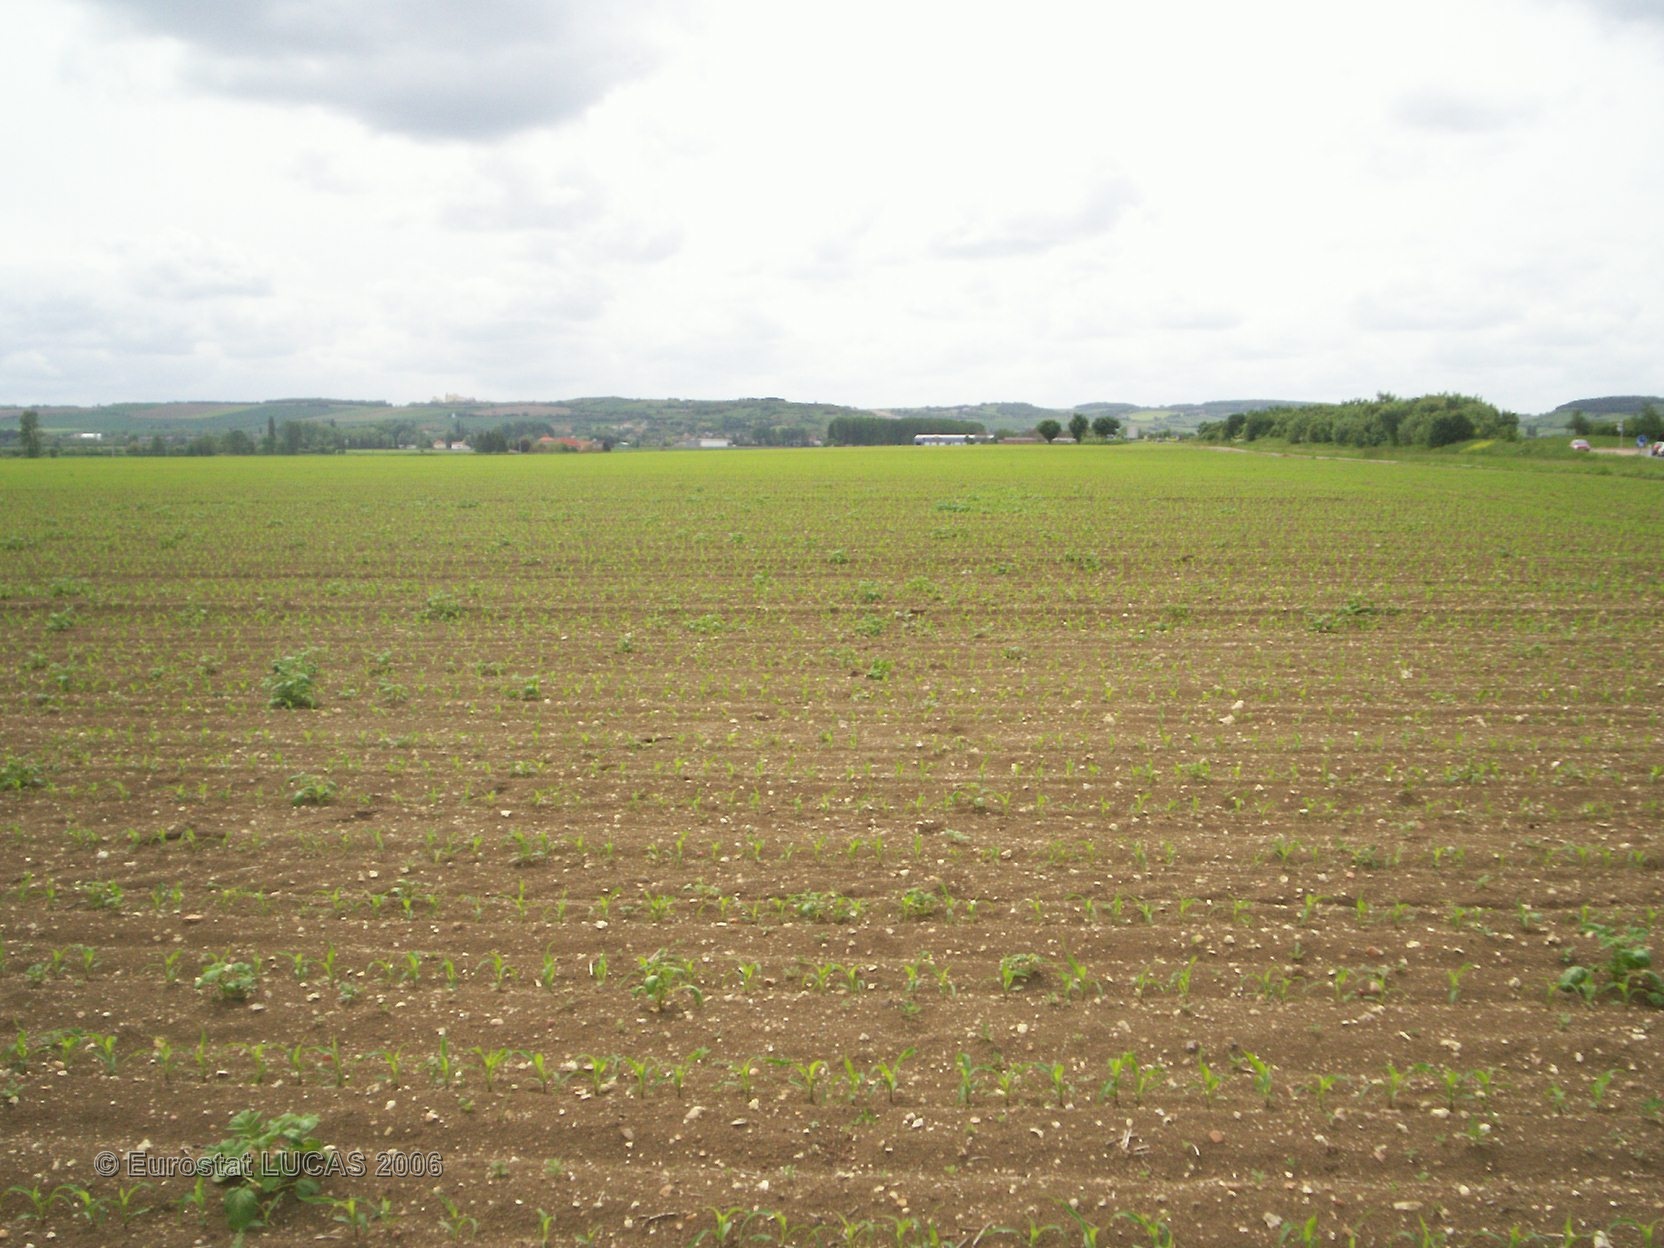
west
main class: Cropland
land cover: Maize
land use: Agriculture (excluding fallow land and kitchen gardens)
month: May
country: FR
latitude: 46.1007
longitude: 3.2337
